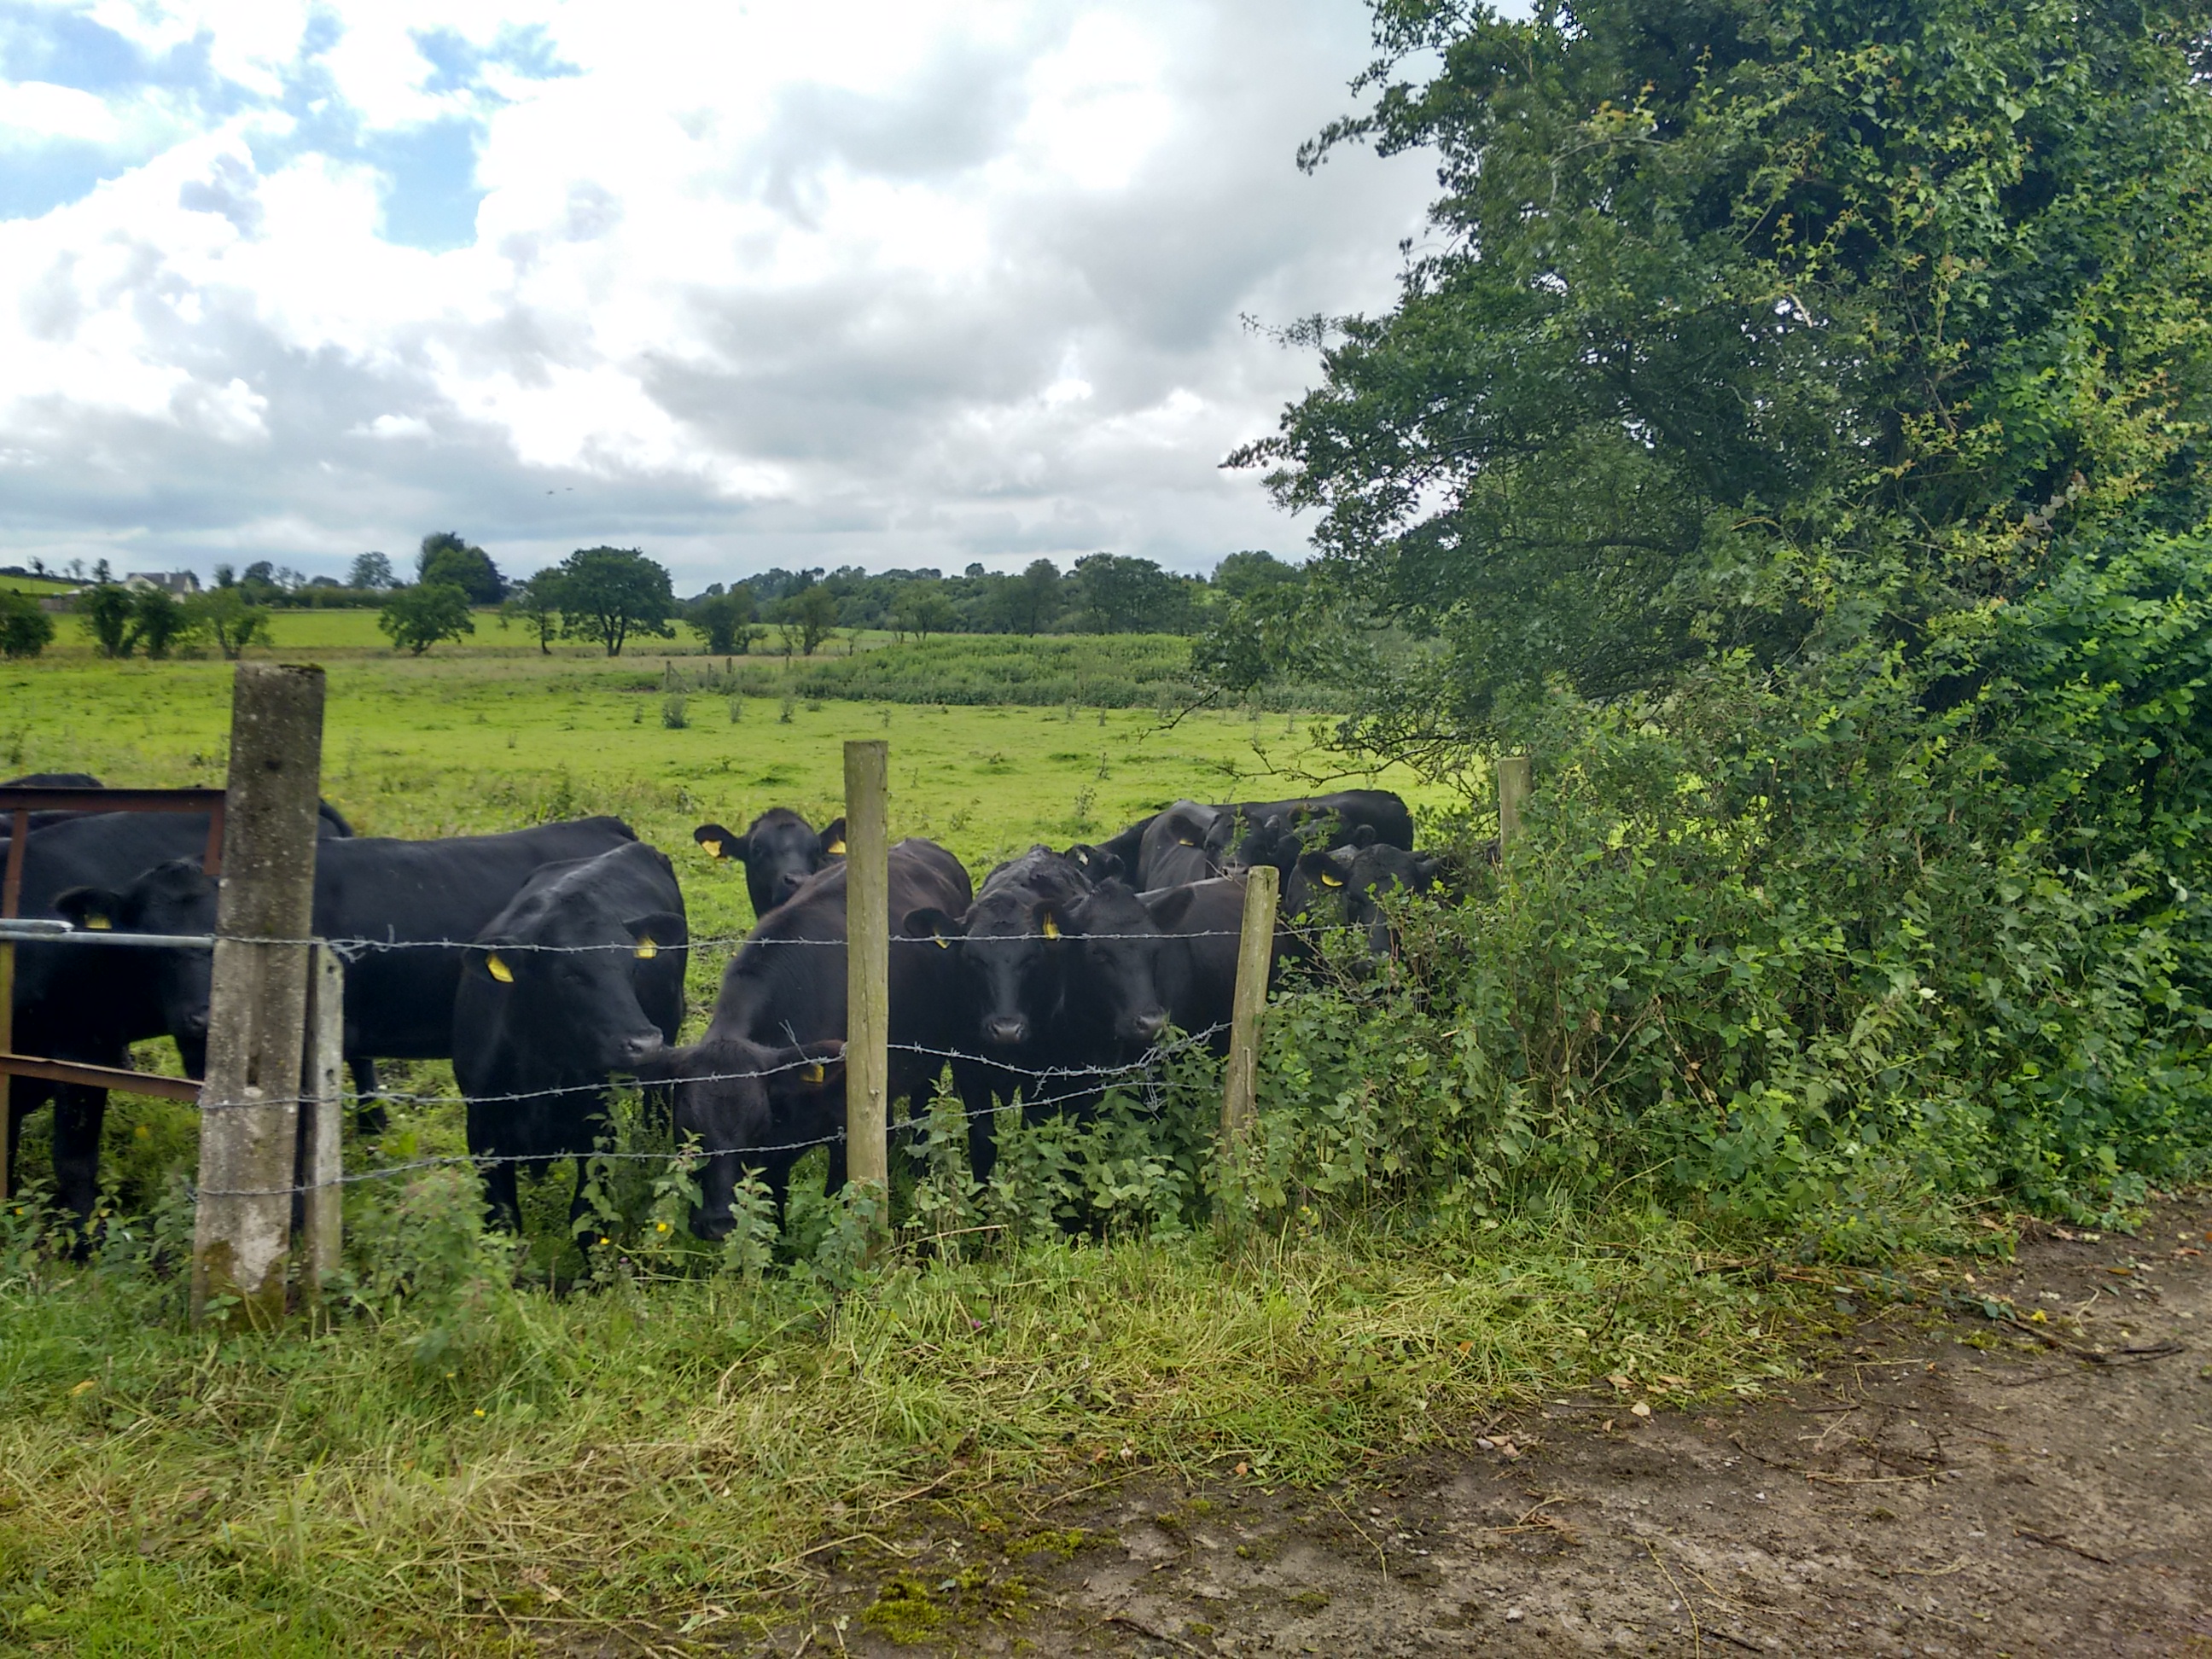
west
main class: Grassland
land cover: Grassland without tree/shrub cover
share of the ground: > 75 %
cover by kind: herbaceous plants 100 %
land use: Agriculture (excluding fallow land and kitchen gardens)
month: July
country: GB
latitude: 54.4005
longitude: -7.3576
